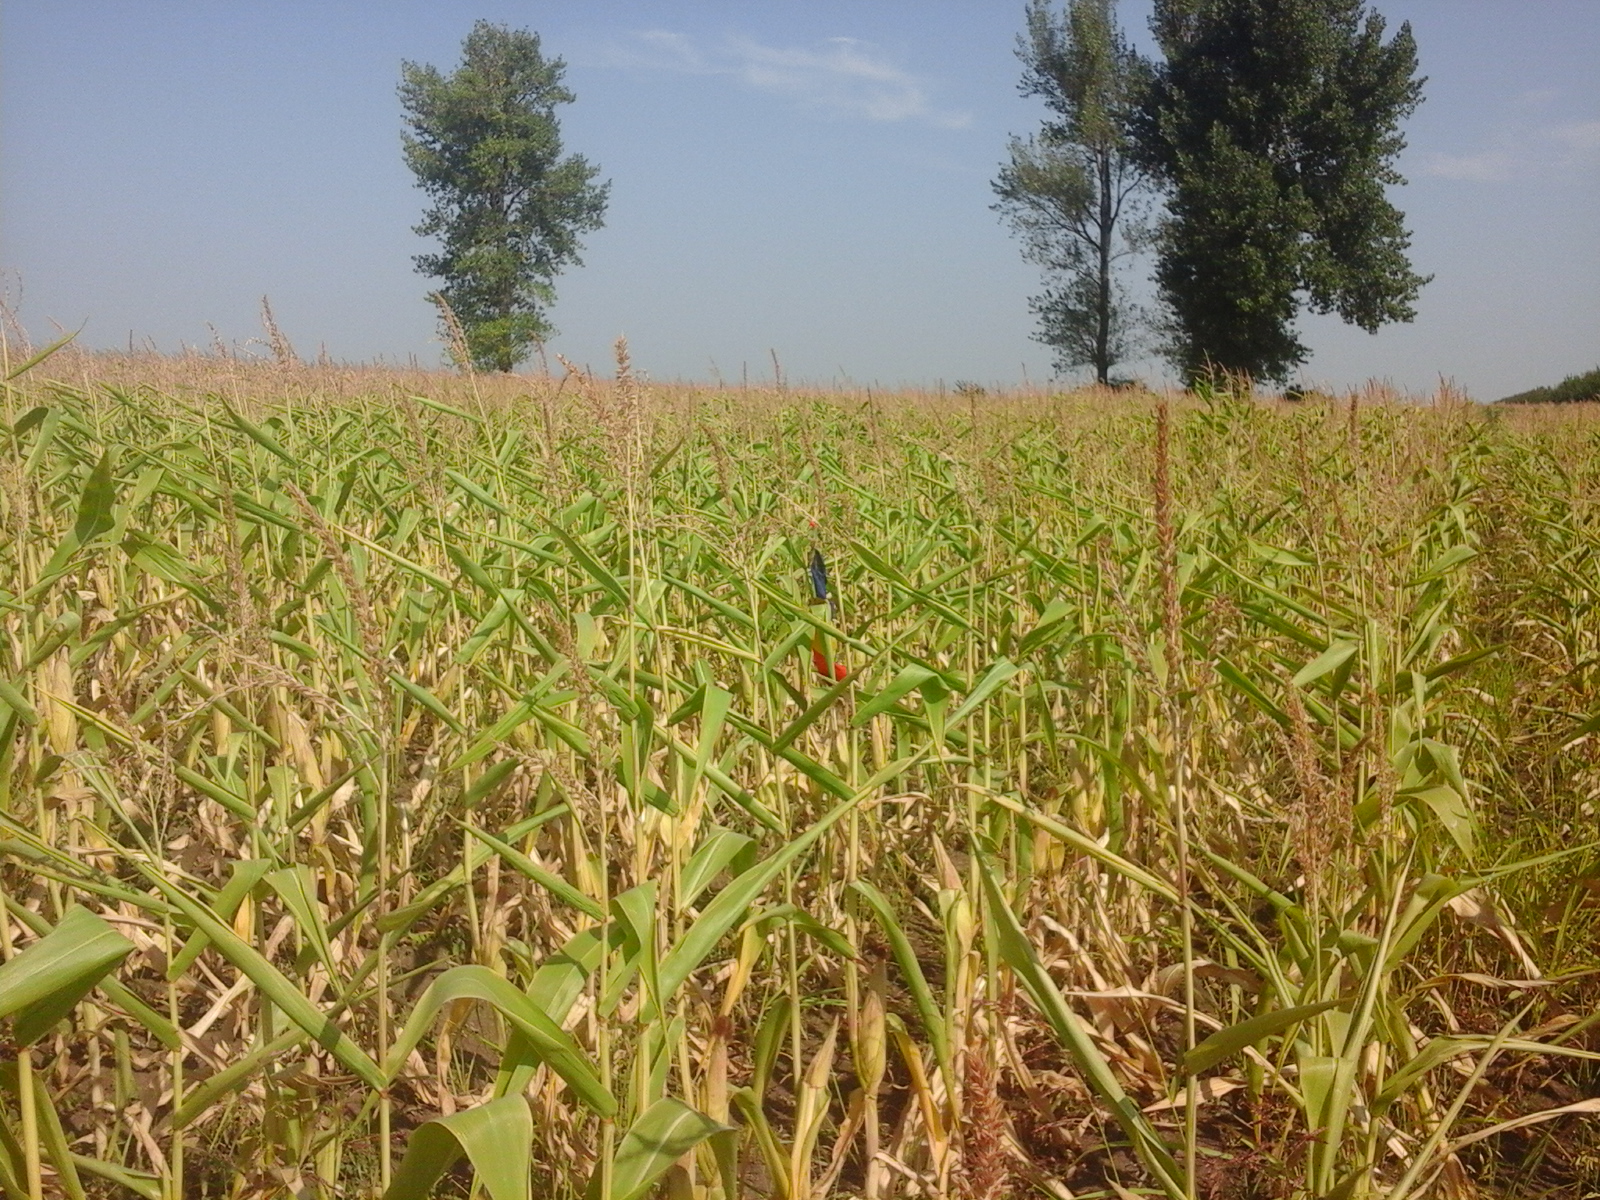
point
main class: Cropland
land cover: Maize
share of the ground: > 75 %
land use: Agriculture (excluding fallow land and kitchen gardens)
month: August
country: RO
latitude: 45.7557
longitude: 27.6313
